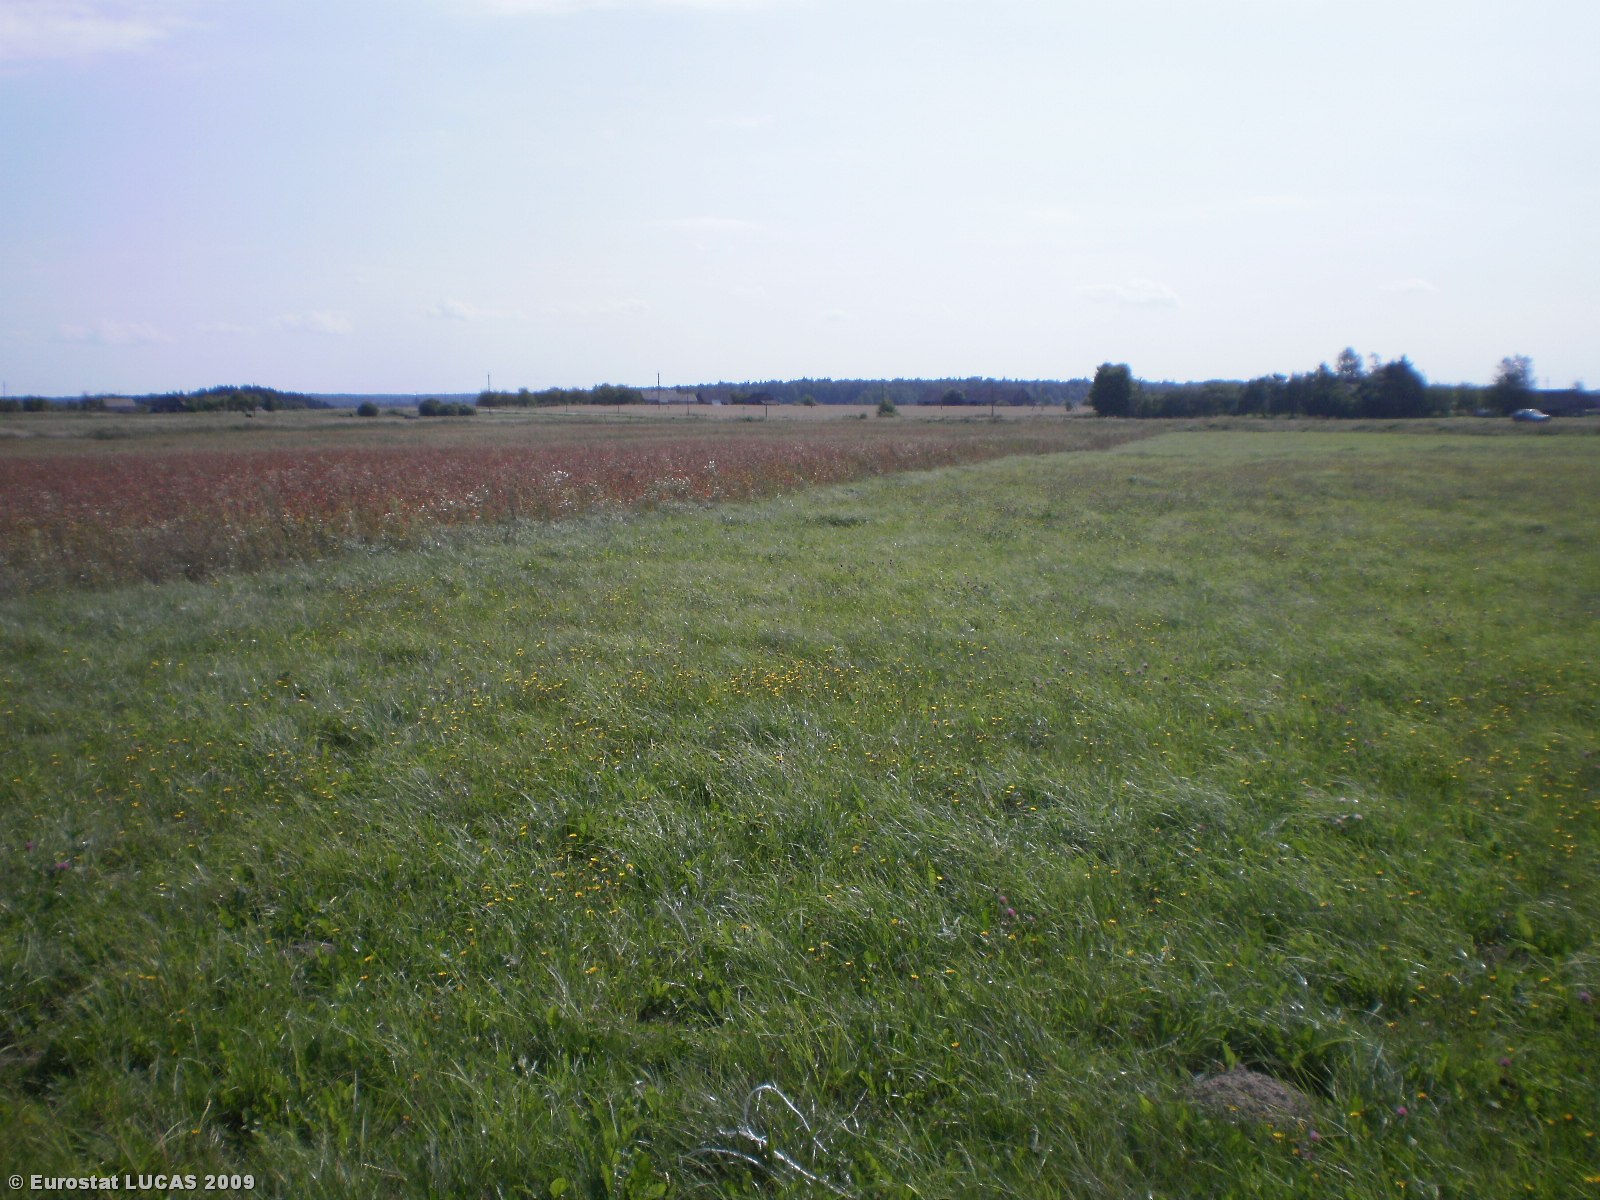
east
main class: Grassland
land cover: Grassland without tree/shrub cover
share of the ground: > 75 %
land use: Agriculture (excluding fallow land and kitchen gardens)
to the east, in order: Grassland without tree/shrub cover; Other cereals; Grass margins; Ditches and canals; Grassland without tree/shrub cover
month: August
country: LT
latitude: 55.0648
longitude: 24.8119
